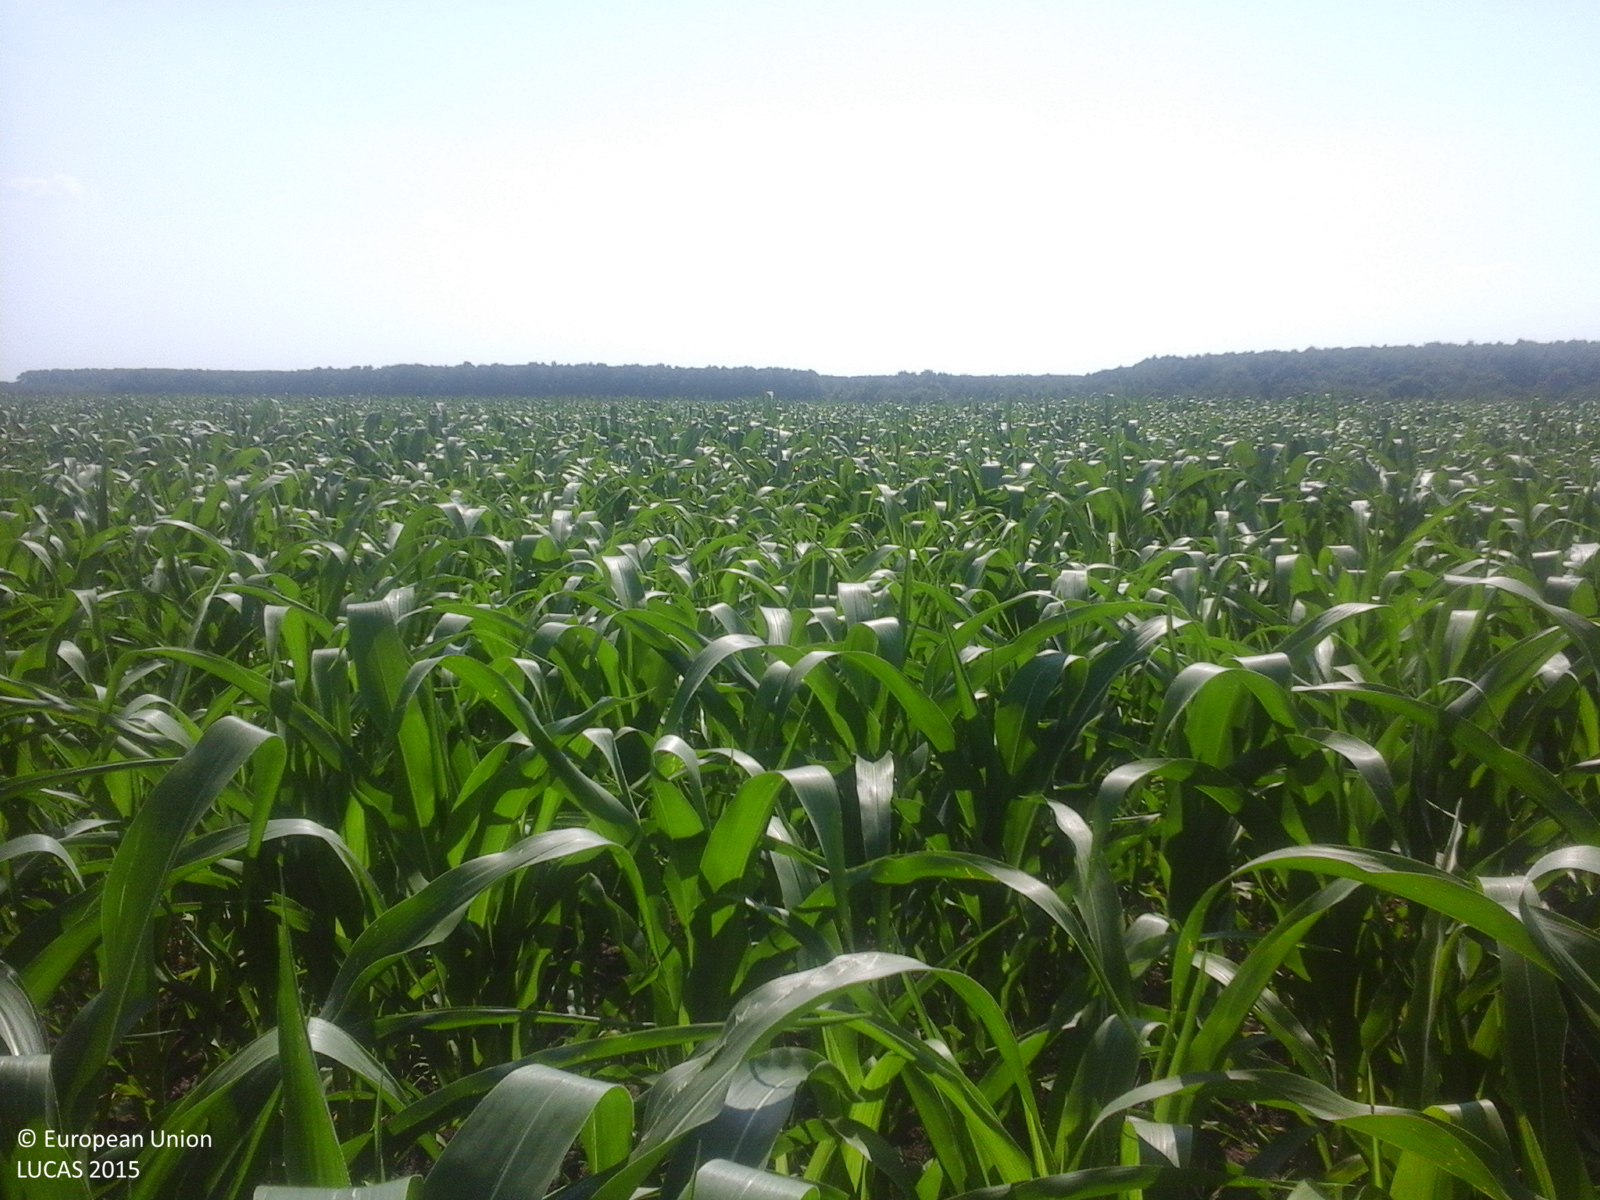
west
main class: Cropland
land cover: Maize
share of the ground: > 75 %
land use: Agriculture (excluding fallow land and kitchen gardens)
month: July
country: RO
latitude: 44.5787
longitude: 24.8257
